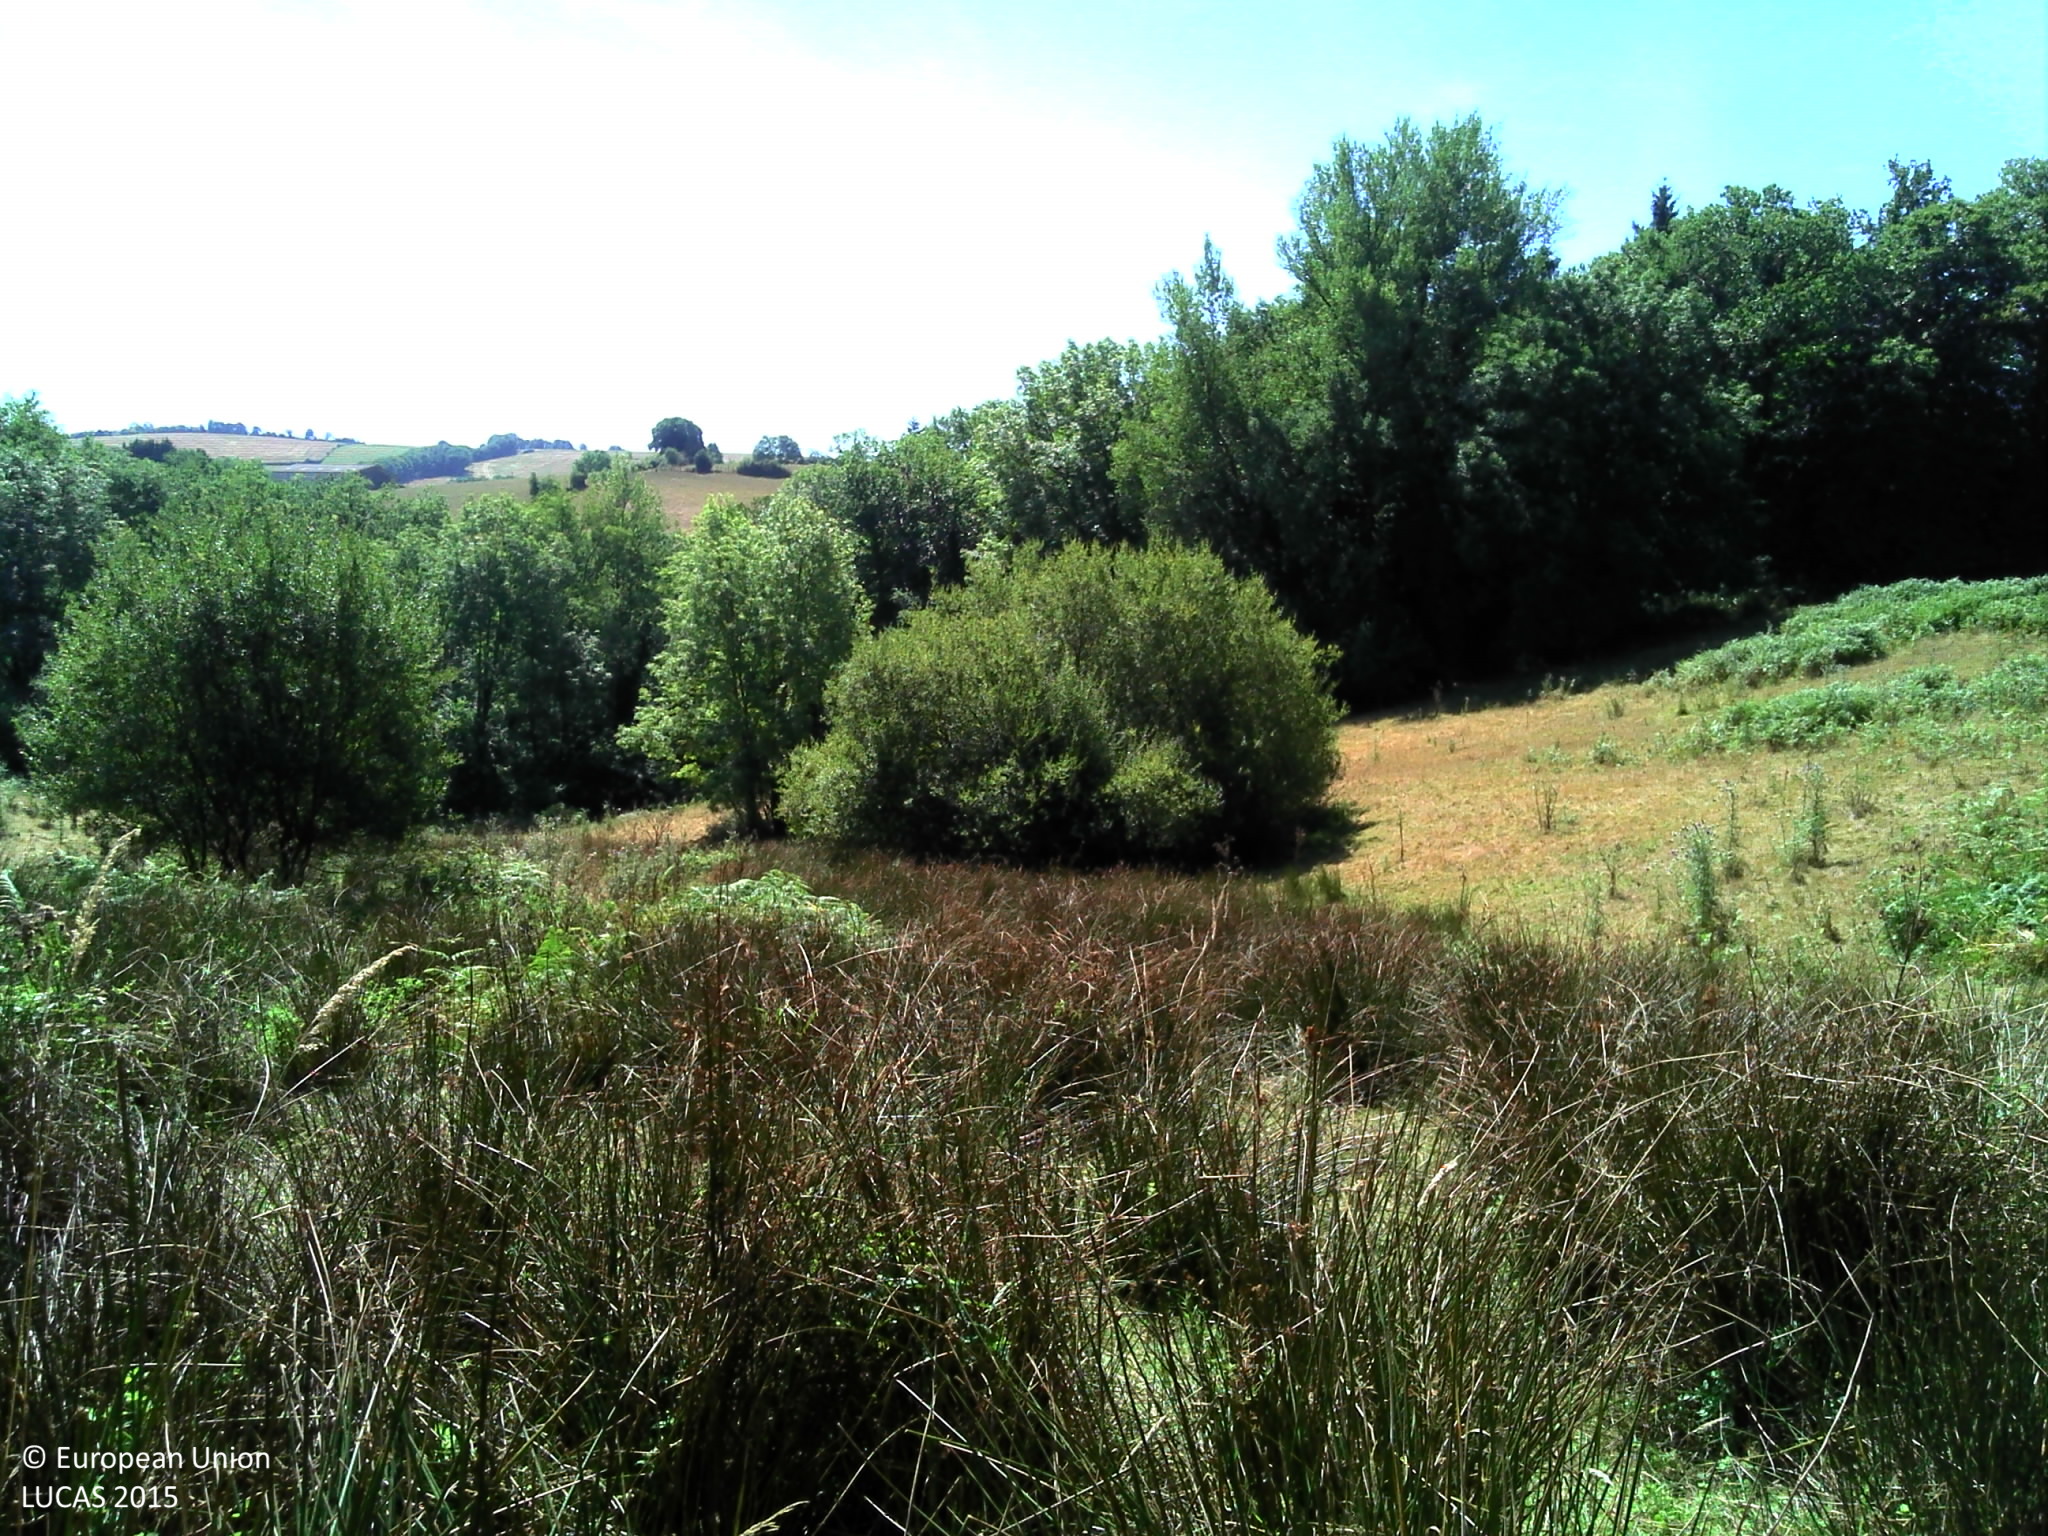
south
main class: Grassland
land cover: Grassland without tree/shrub cover
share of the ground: > 75 %
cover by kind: herbaceous plants 100 %
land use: Agriculture (excluding fallow land and kitchen gardens)
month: August
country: FR
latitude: 43.9784
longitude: 2.6126
